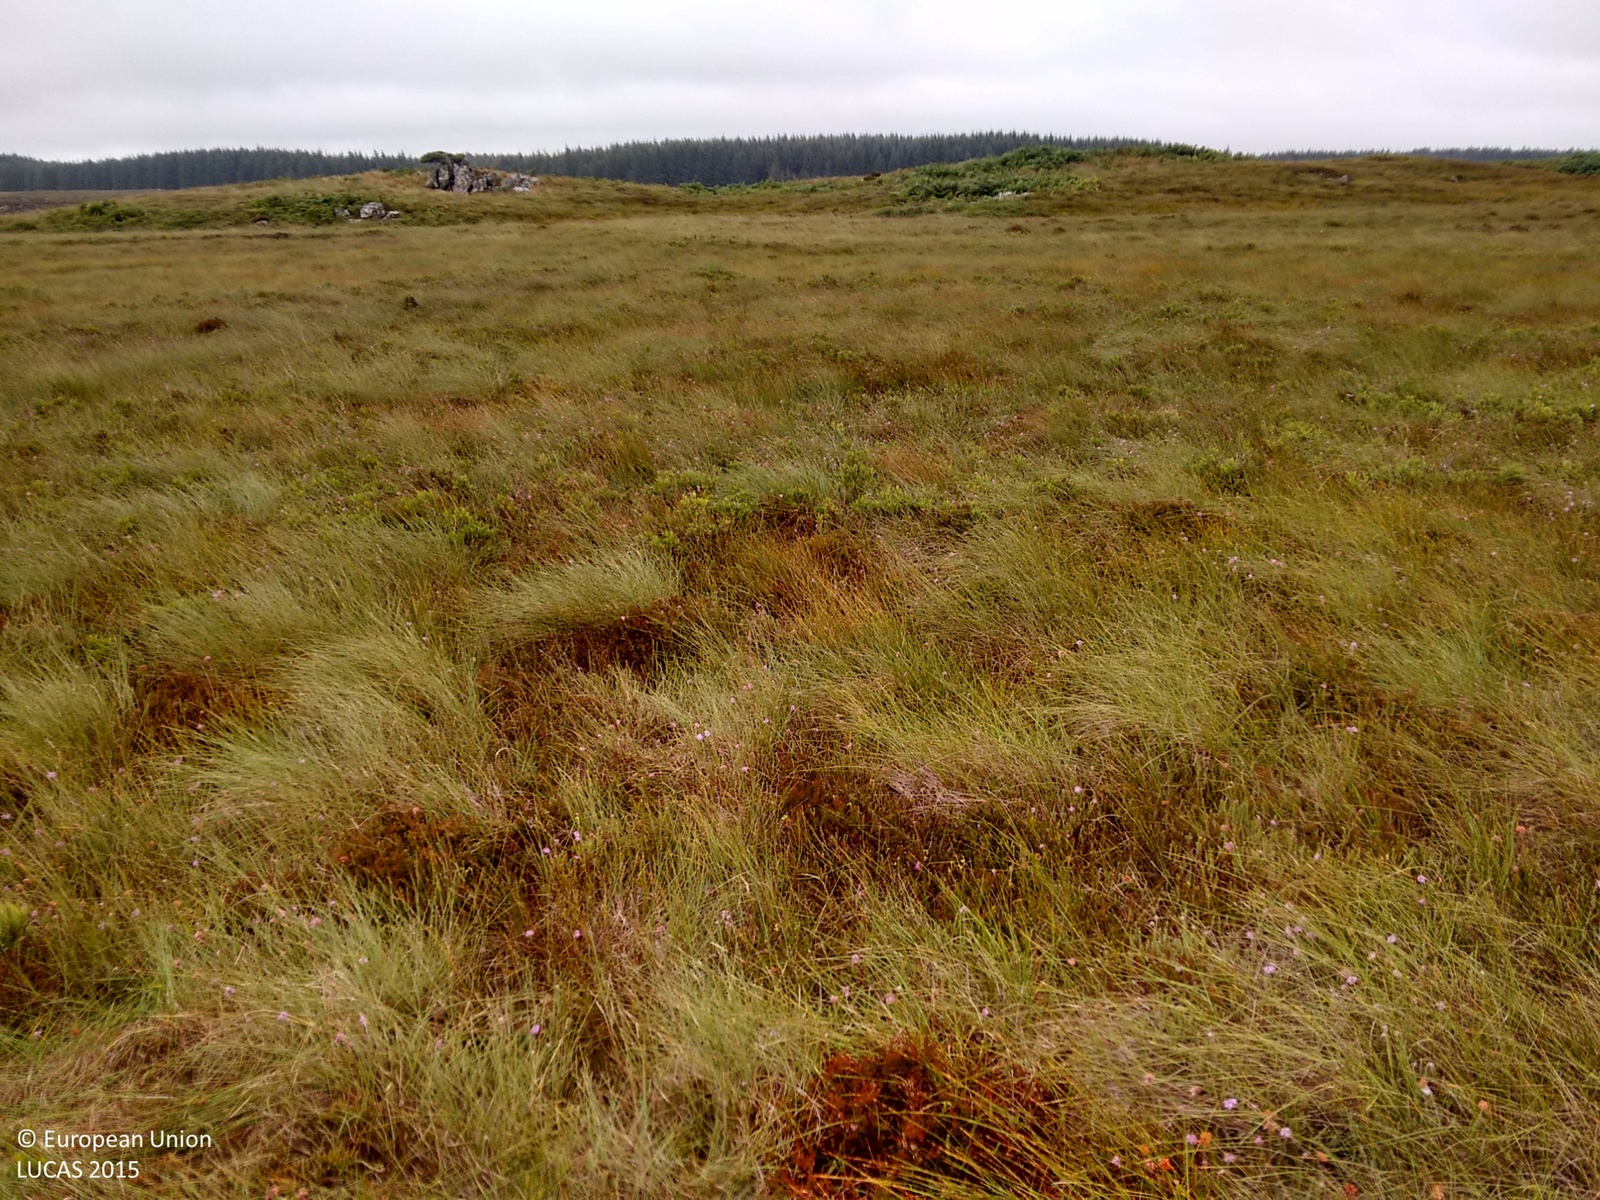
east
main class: Shrubland
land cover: Shrubland without tree cover
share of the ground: 50 - 75 %
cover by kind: shrubs 60 %, herbaceous plants 40 %
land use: Semi-natural and natural areas not in use
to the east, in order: Shrubland without tree cover; Peatbogs
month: August
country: GB
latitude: 54.8478
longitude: -4.6358
